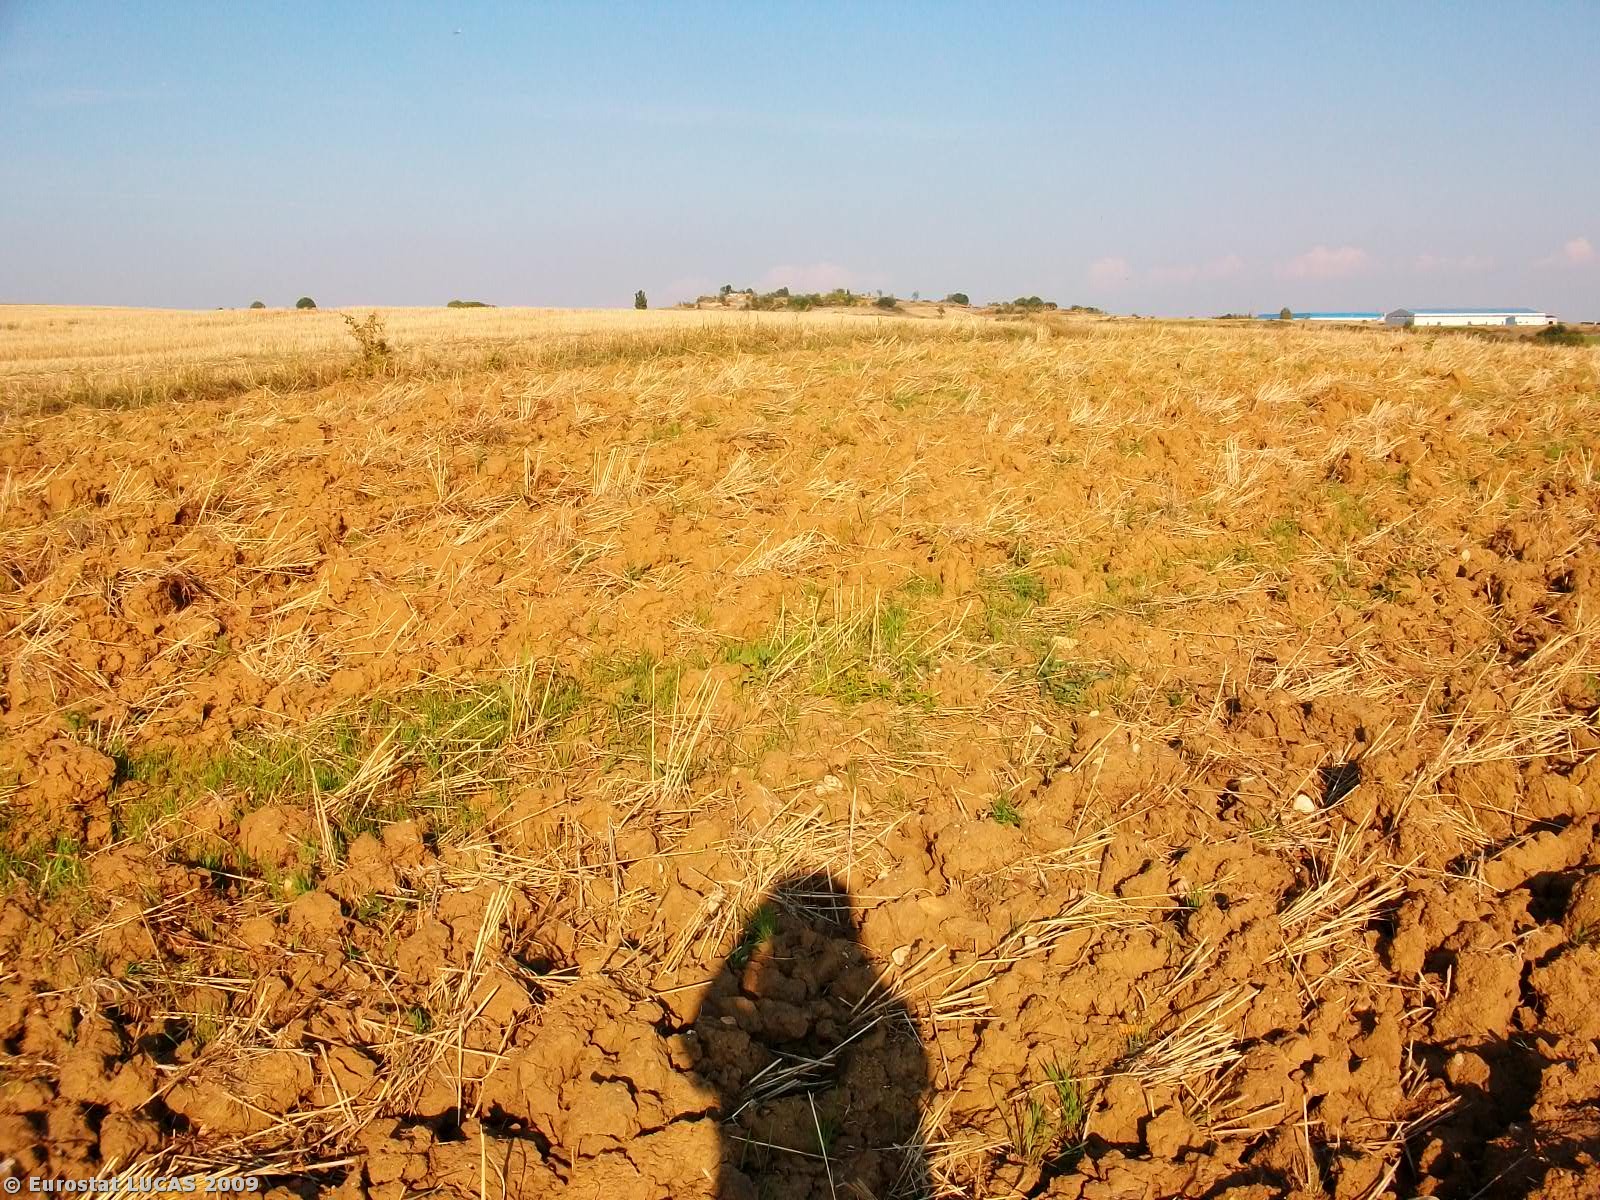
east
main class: Cropland
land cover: Common wheat
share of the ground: < 10 %
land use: Agriculture (excluding fallow land and kitchen gardens)
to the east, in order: Common wheat; Grass margins; Single bushes/trees; Common wheat
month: September
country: GR
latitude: 41.1811
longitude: 26.2699
